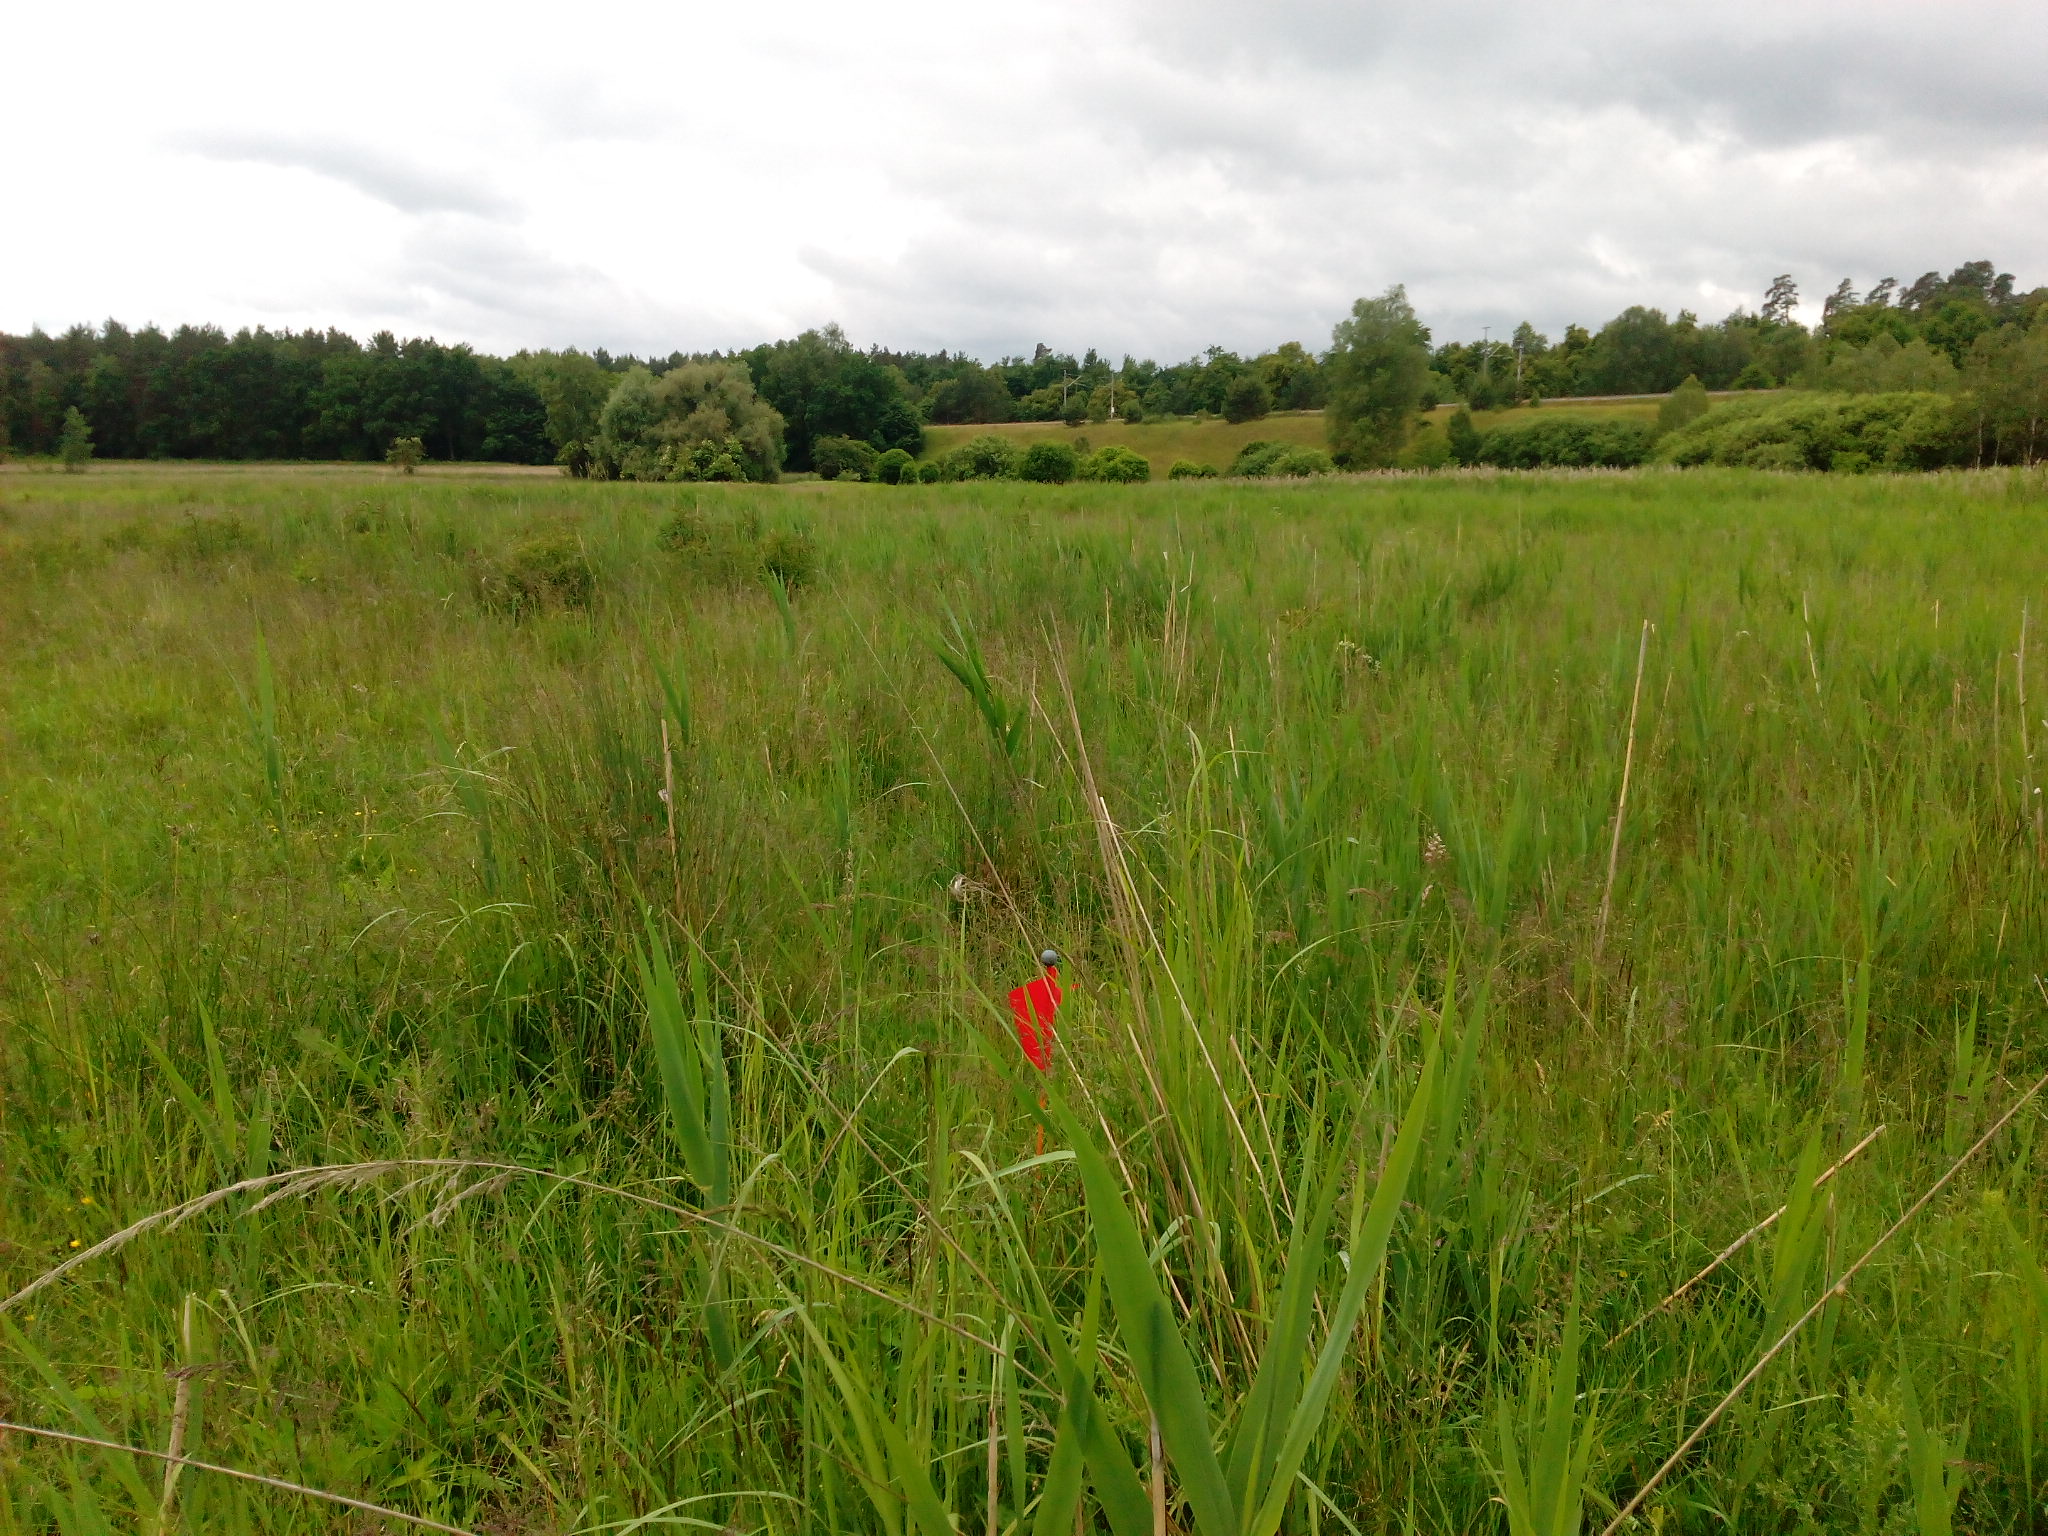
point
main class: Grassland
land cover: Grassland without tree/shrub cover
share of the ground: > 75 %
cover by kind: herbaceous plants 100 %
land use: Agriculture (excluding fallow land and kitchen gardens)
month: June
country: DE
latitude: 53.1084
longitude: 13.1815
